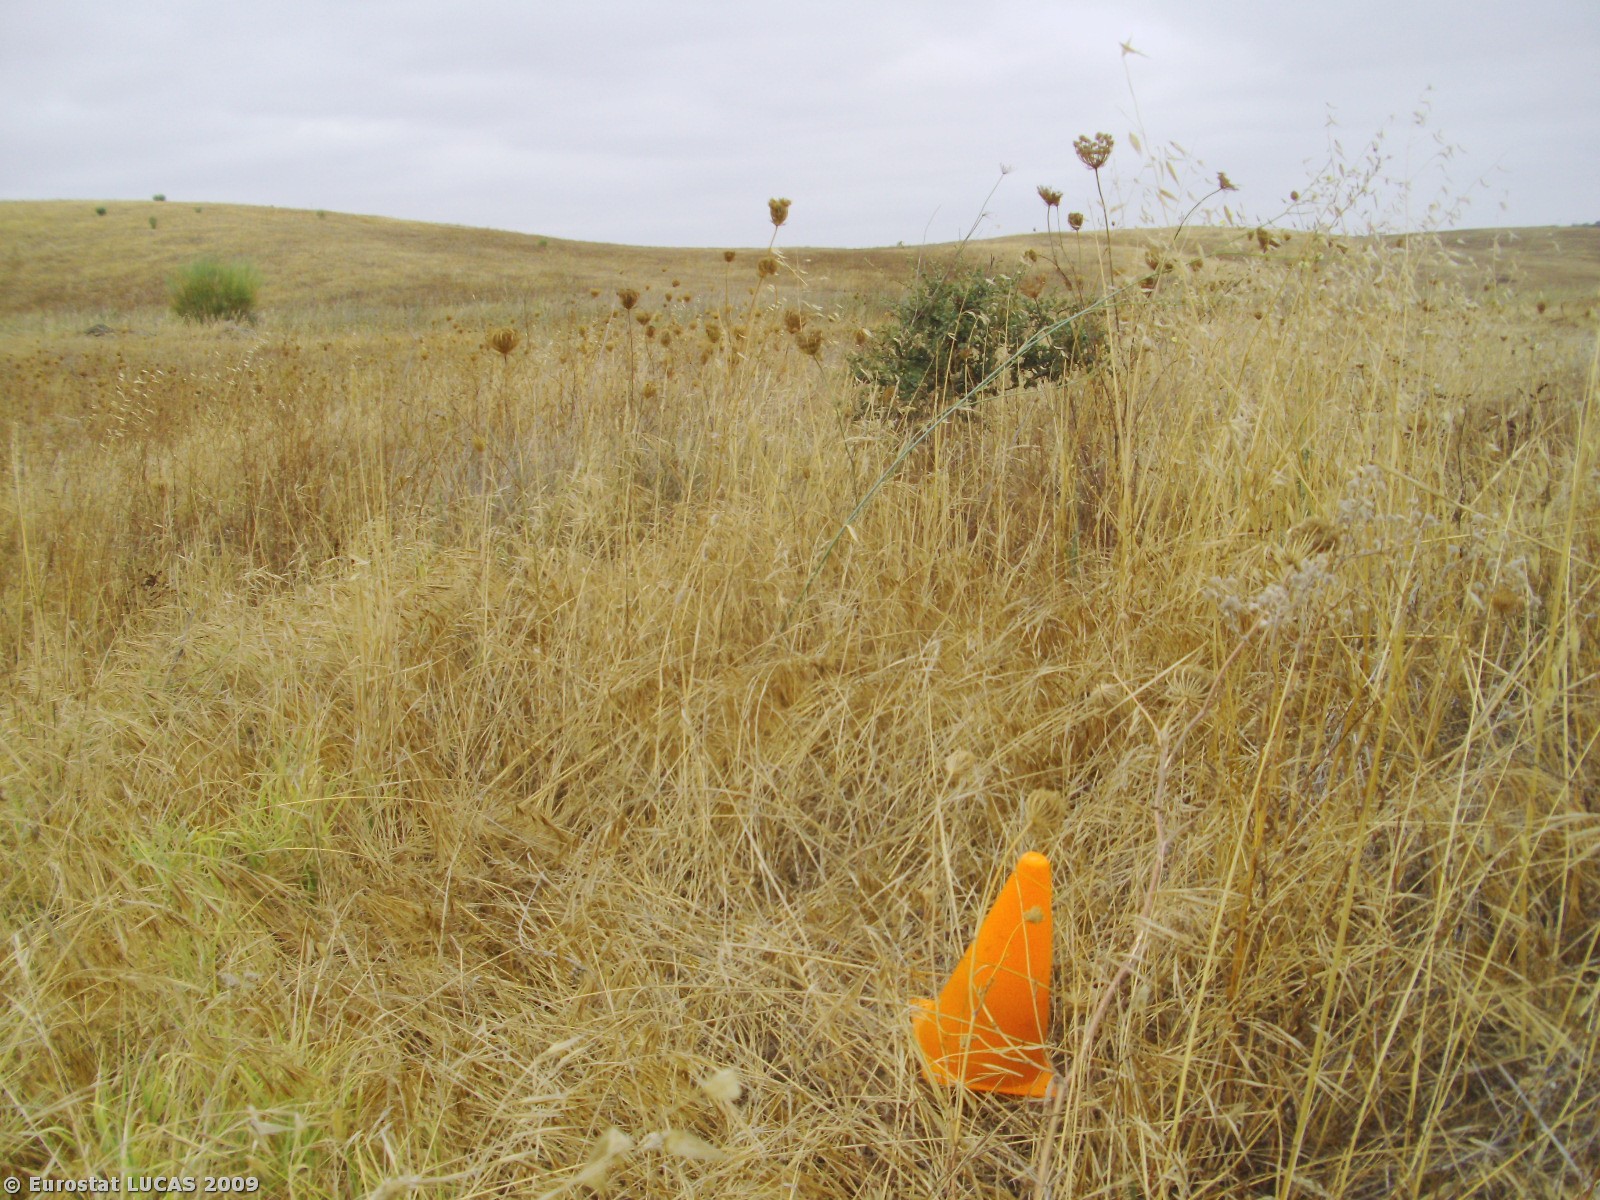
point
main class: Grassland
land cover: Spontaneously vegetated surfaces
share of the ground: > 75 %
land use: Fallow land
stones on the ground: < 10 %
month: August
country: PT
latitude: 38.4426
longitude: -7.6875
